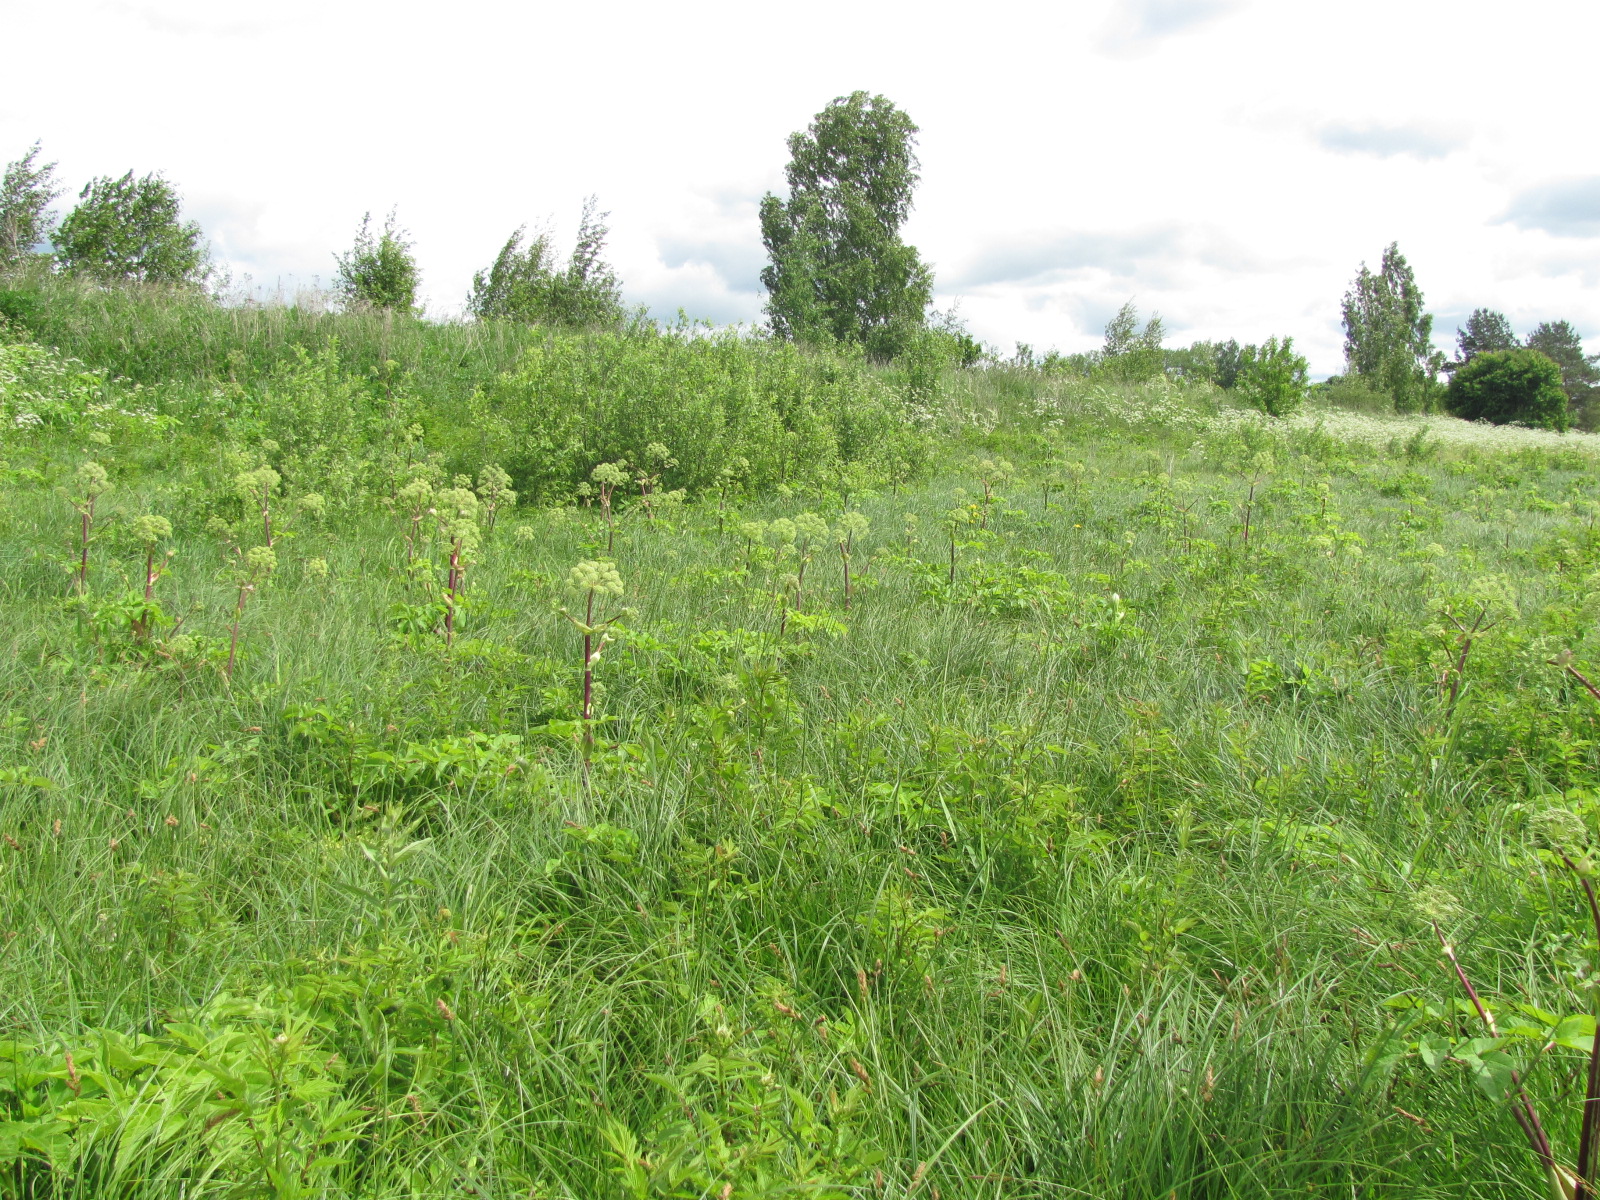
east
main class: Grassland
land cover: Grassland without tree/shrub cover
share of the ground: > 75 %
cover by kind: herbaceous plants 100 %
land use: Semi-natural and natural areas not in use
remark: Temporary flooded
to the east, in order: Grassland without tree/shrub cover; Broadleaved woodland; Inland fresh water bodies
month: June
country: LV
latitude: 56.6440
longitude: 23.7946
